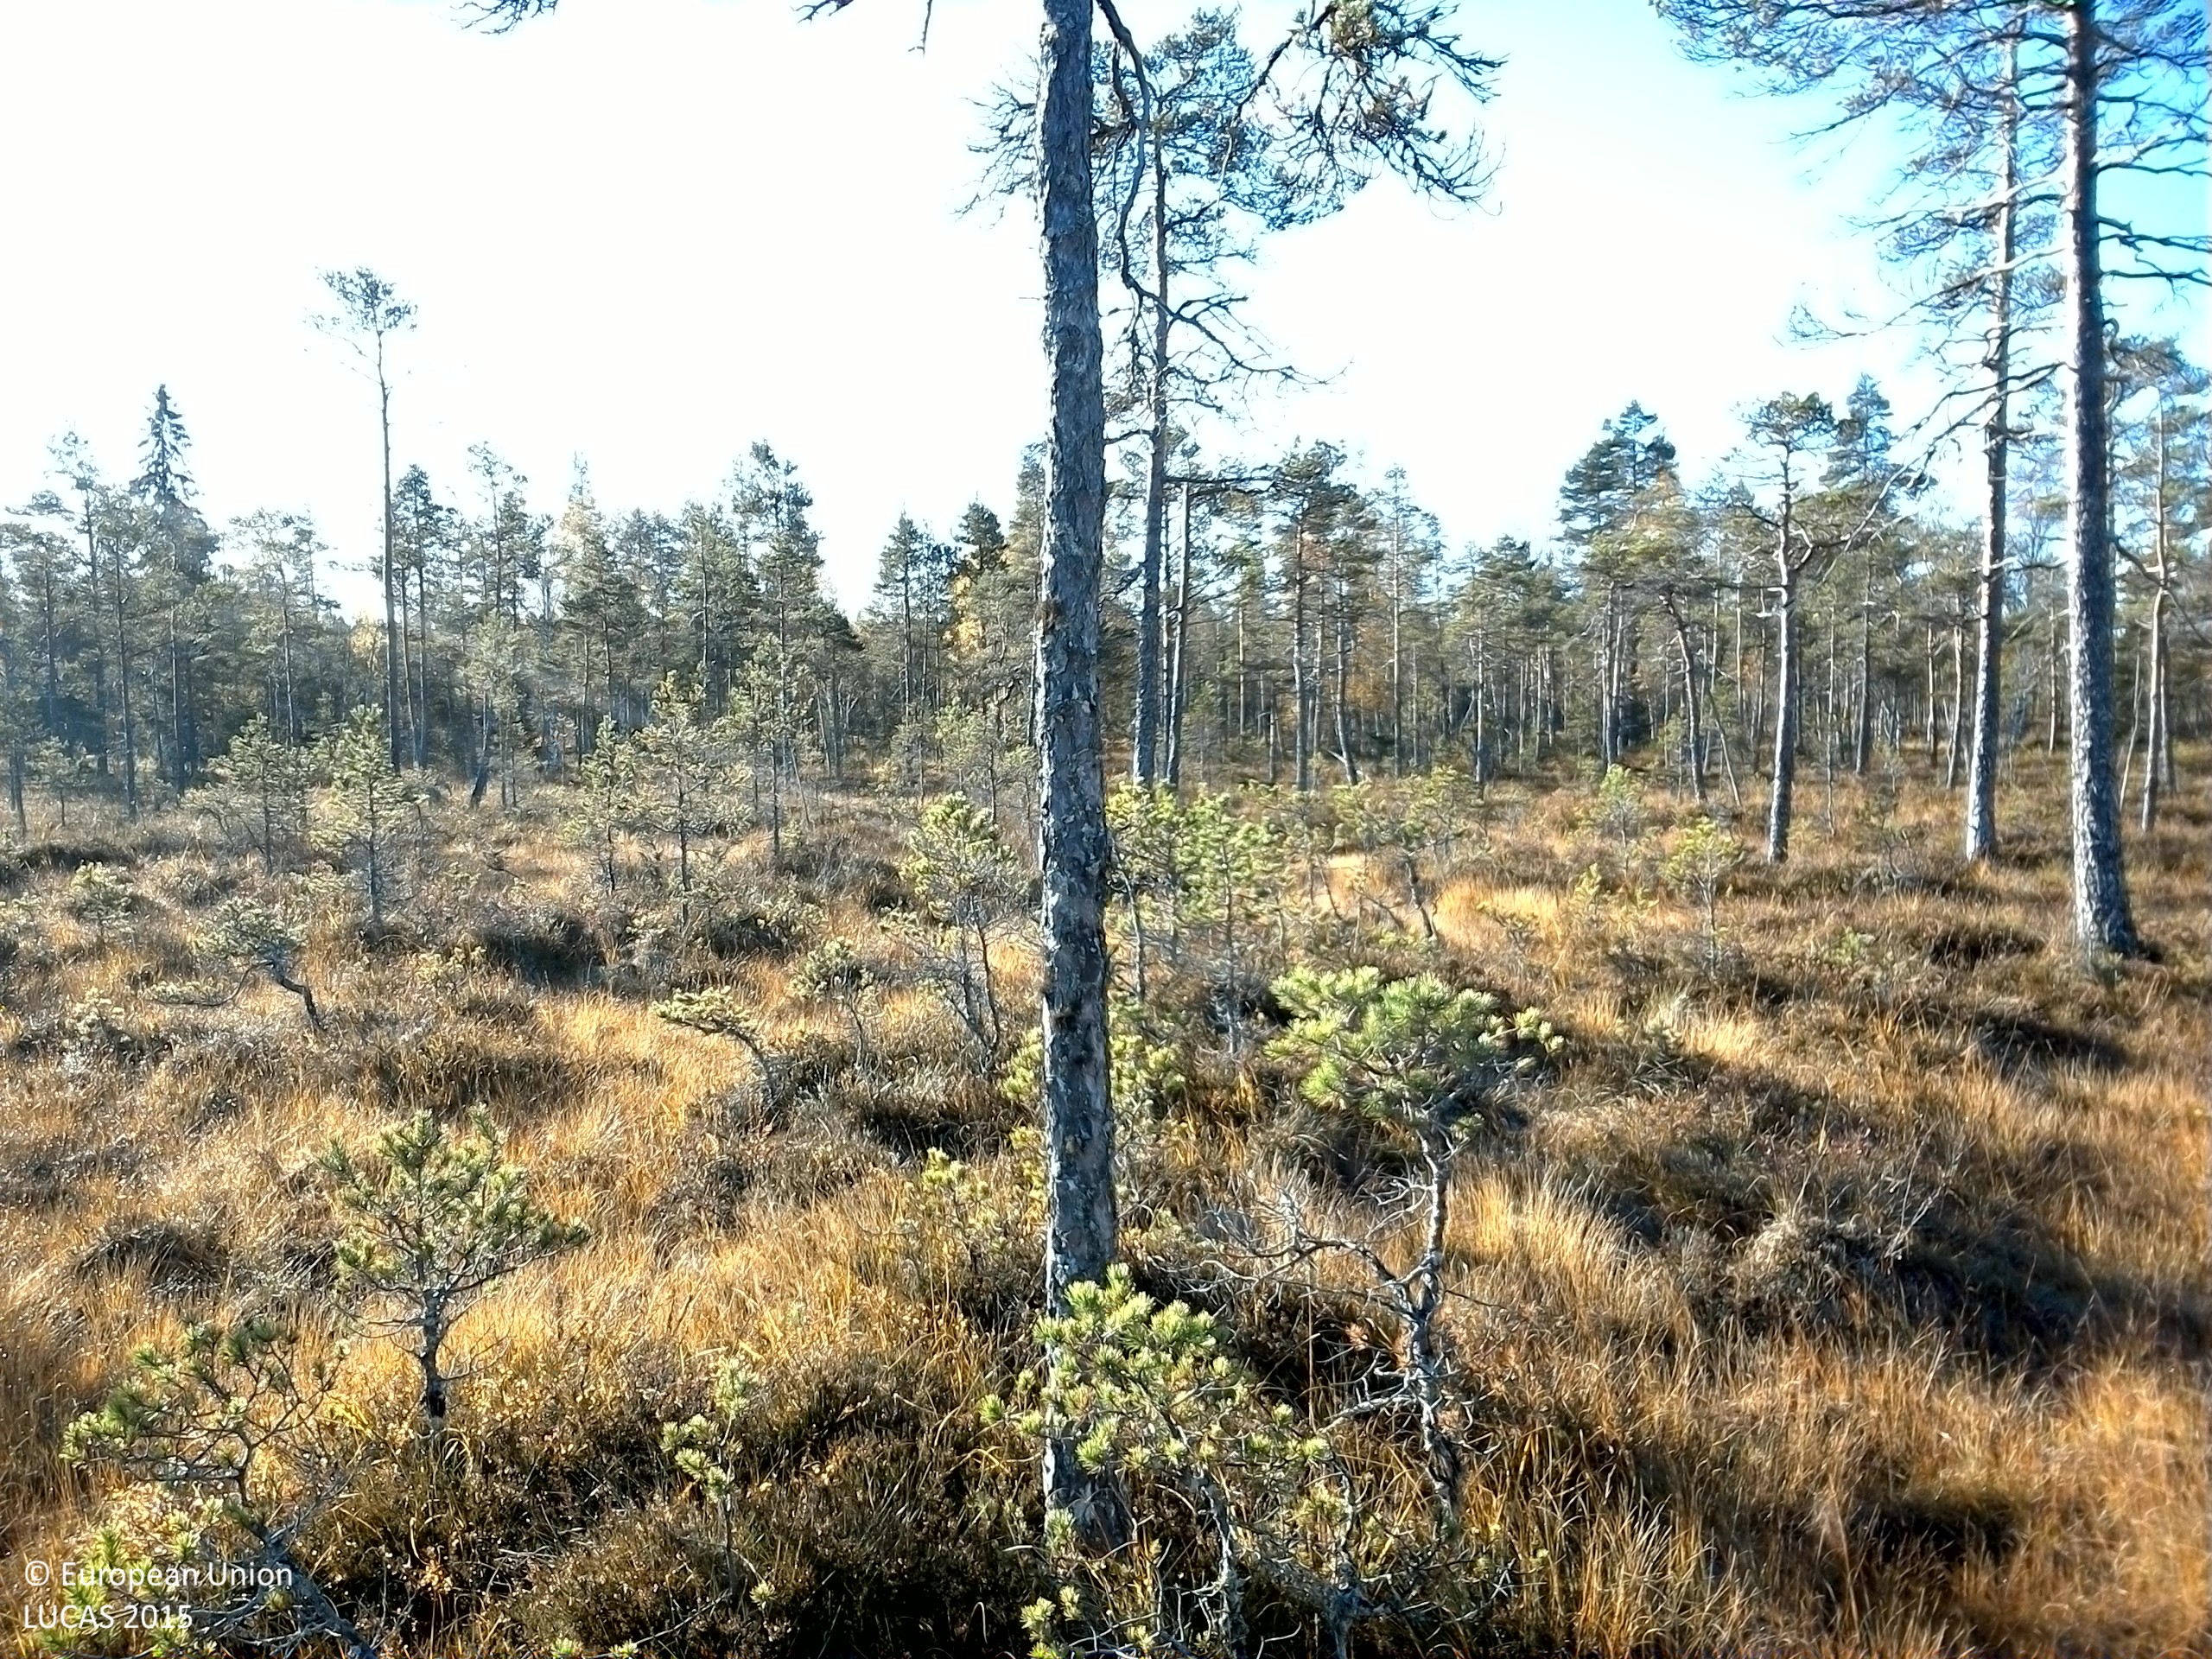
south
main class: Woodland
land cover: Pine dominated coniferous woodland
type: boreal forest
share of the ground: 10 - 25 %
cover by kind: shrubs 40 %, coniferous forest trees 20 %, herbaceous plants 20 %, lichens and mosses 20 %
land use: Forestry
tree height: < 5 m
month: October
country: SE
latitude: 61.1994
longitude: 15.3256
